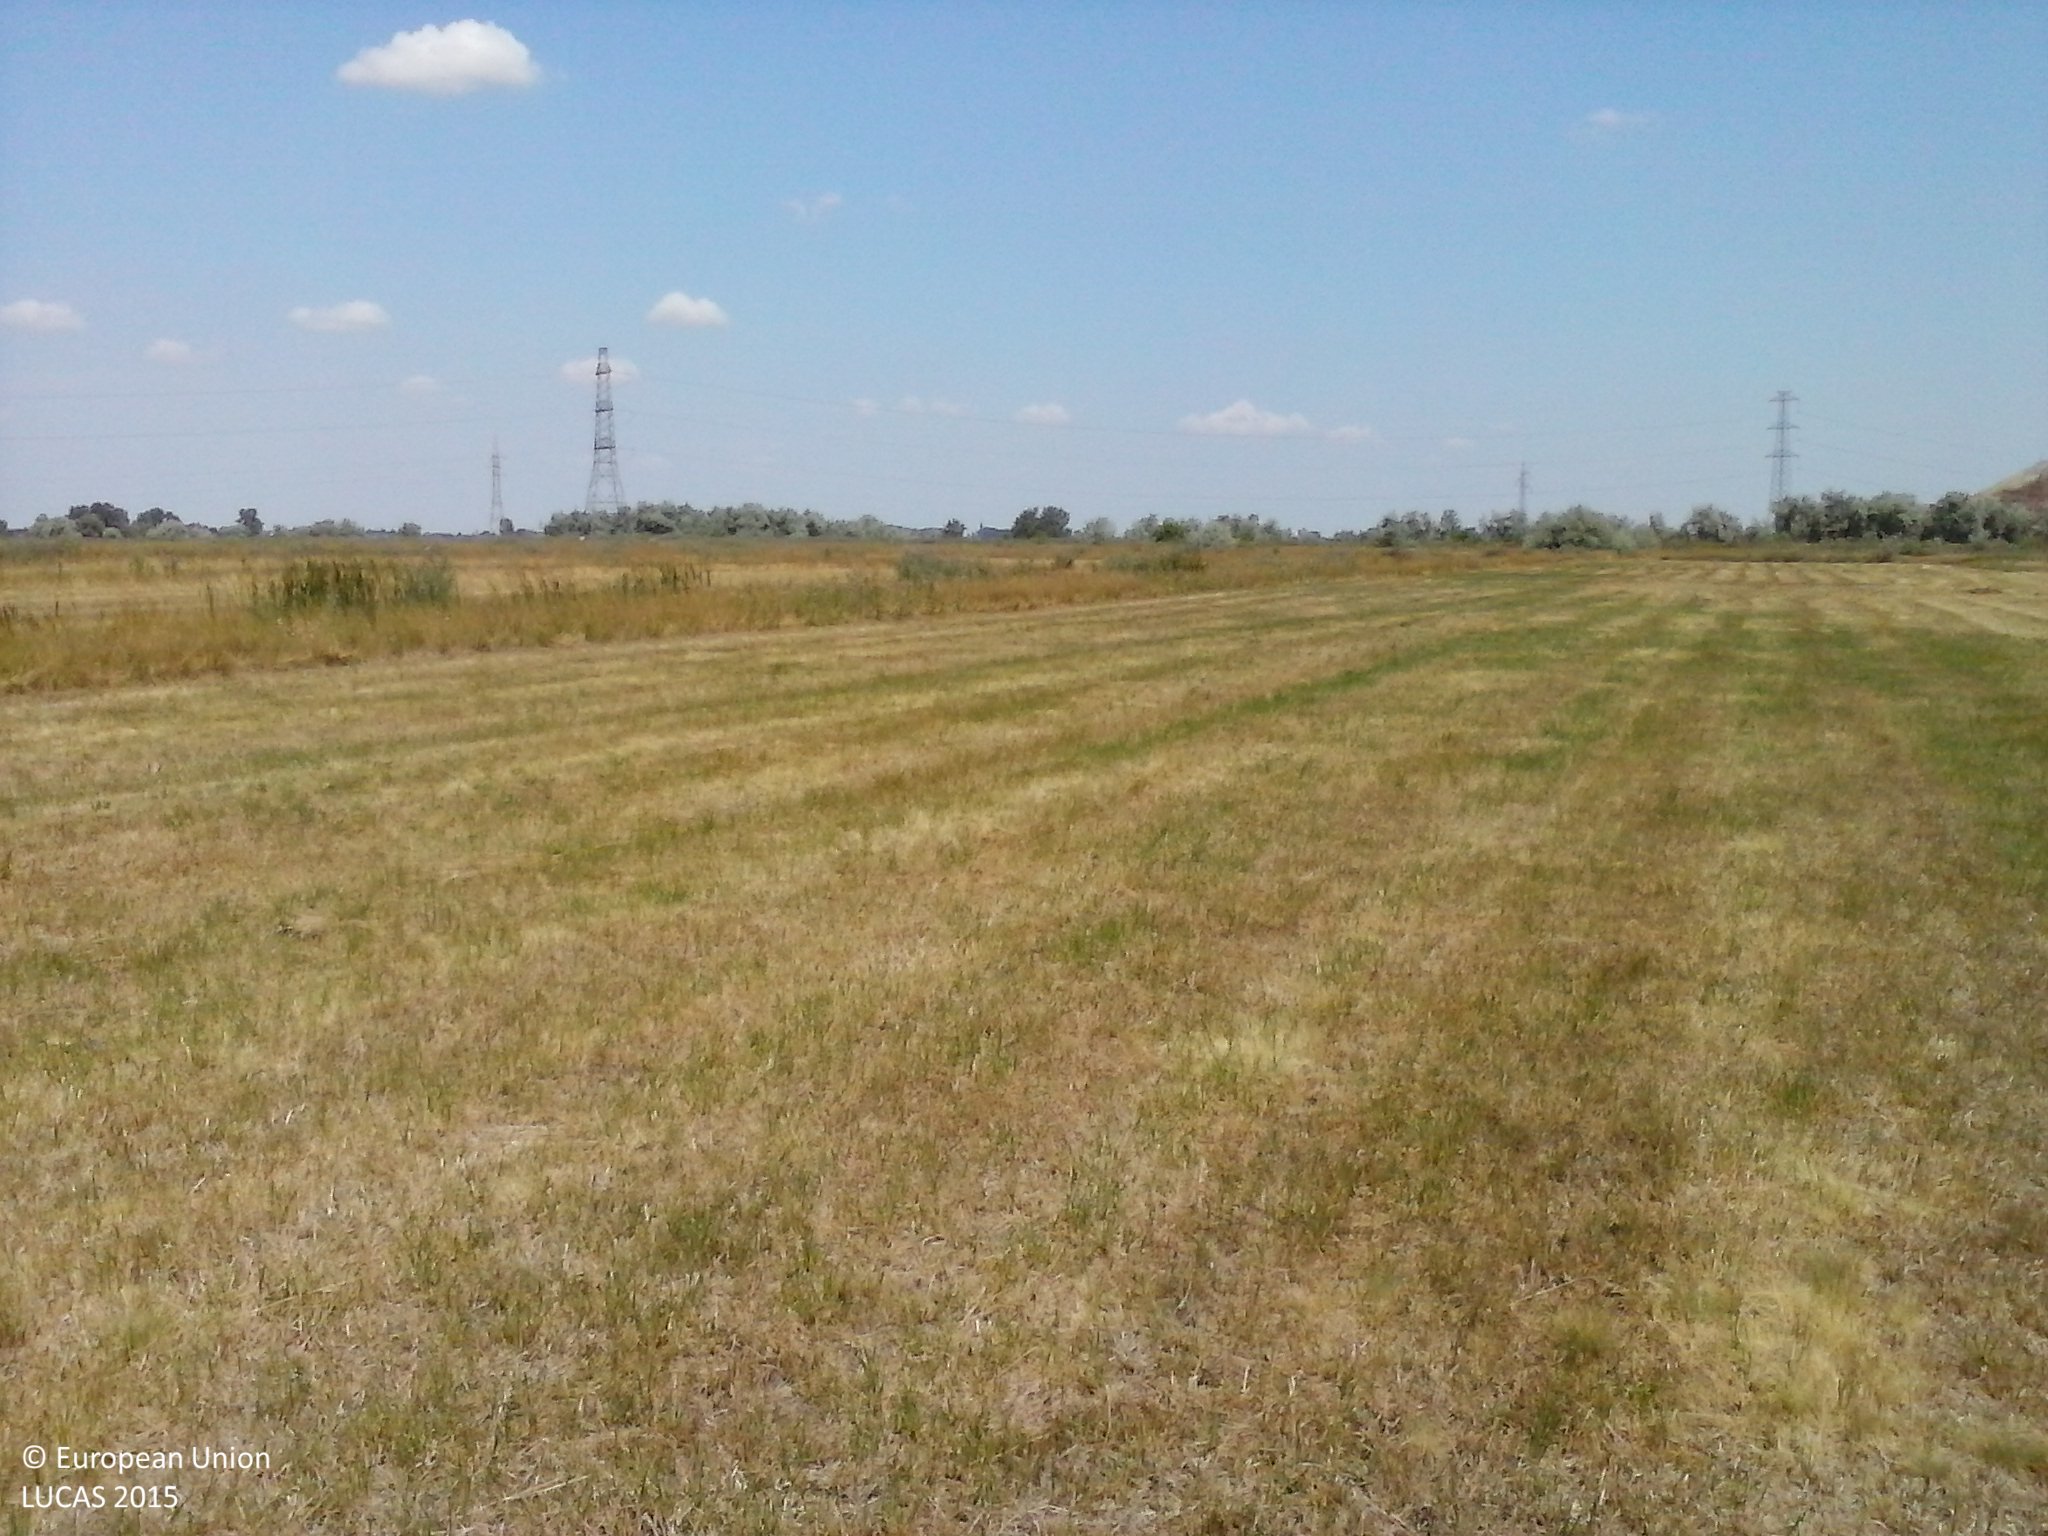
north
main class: Grassland
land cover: Grassland without tree/shrub cover
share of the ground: > 75 %
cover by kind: herbaceous plants 100 %
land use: Agriculture (excluding fallow land and kitchen gardens)
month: January
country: HU
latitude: 46.3757
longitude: 20.3338
